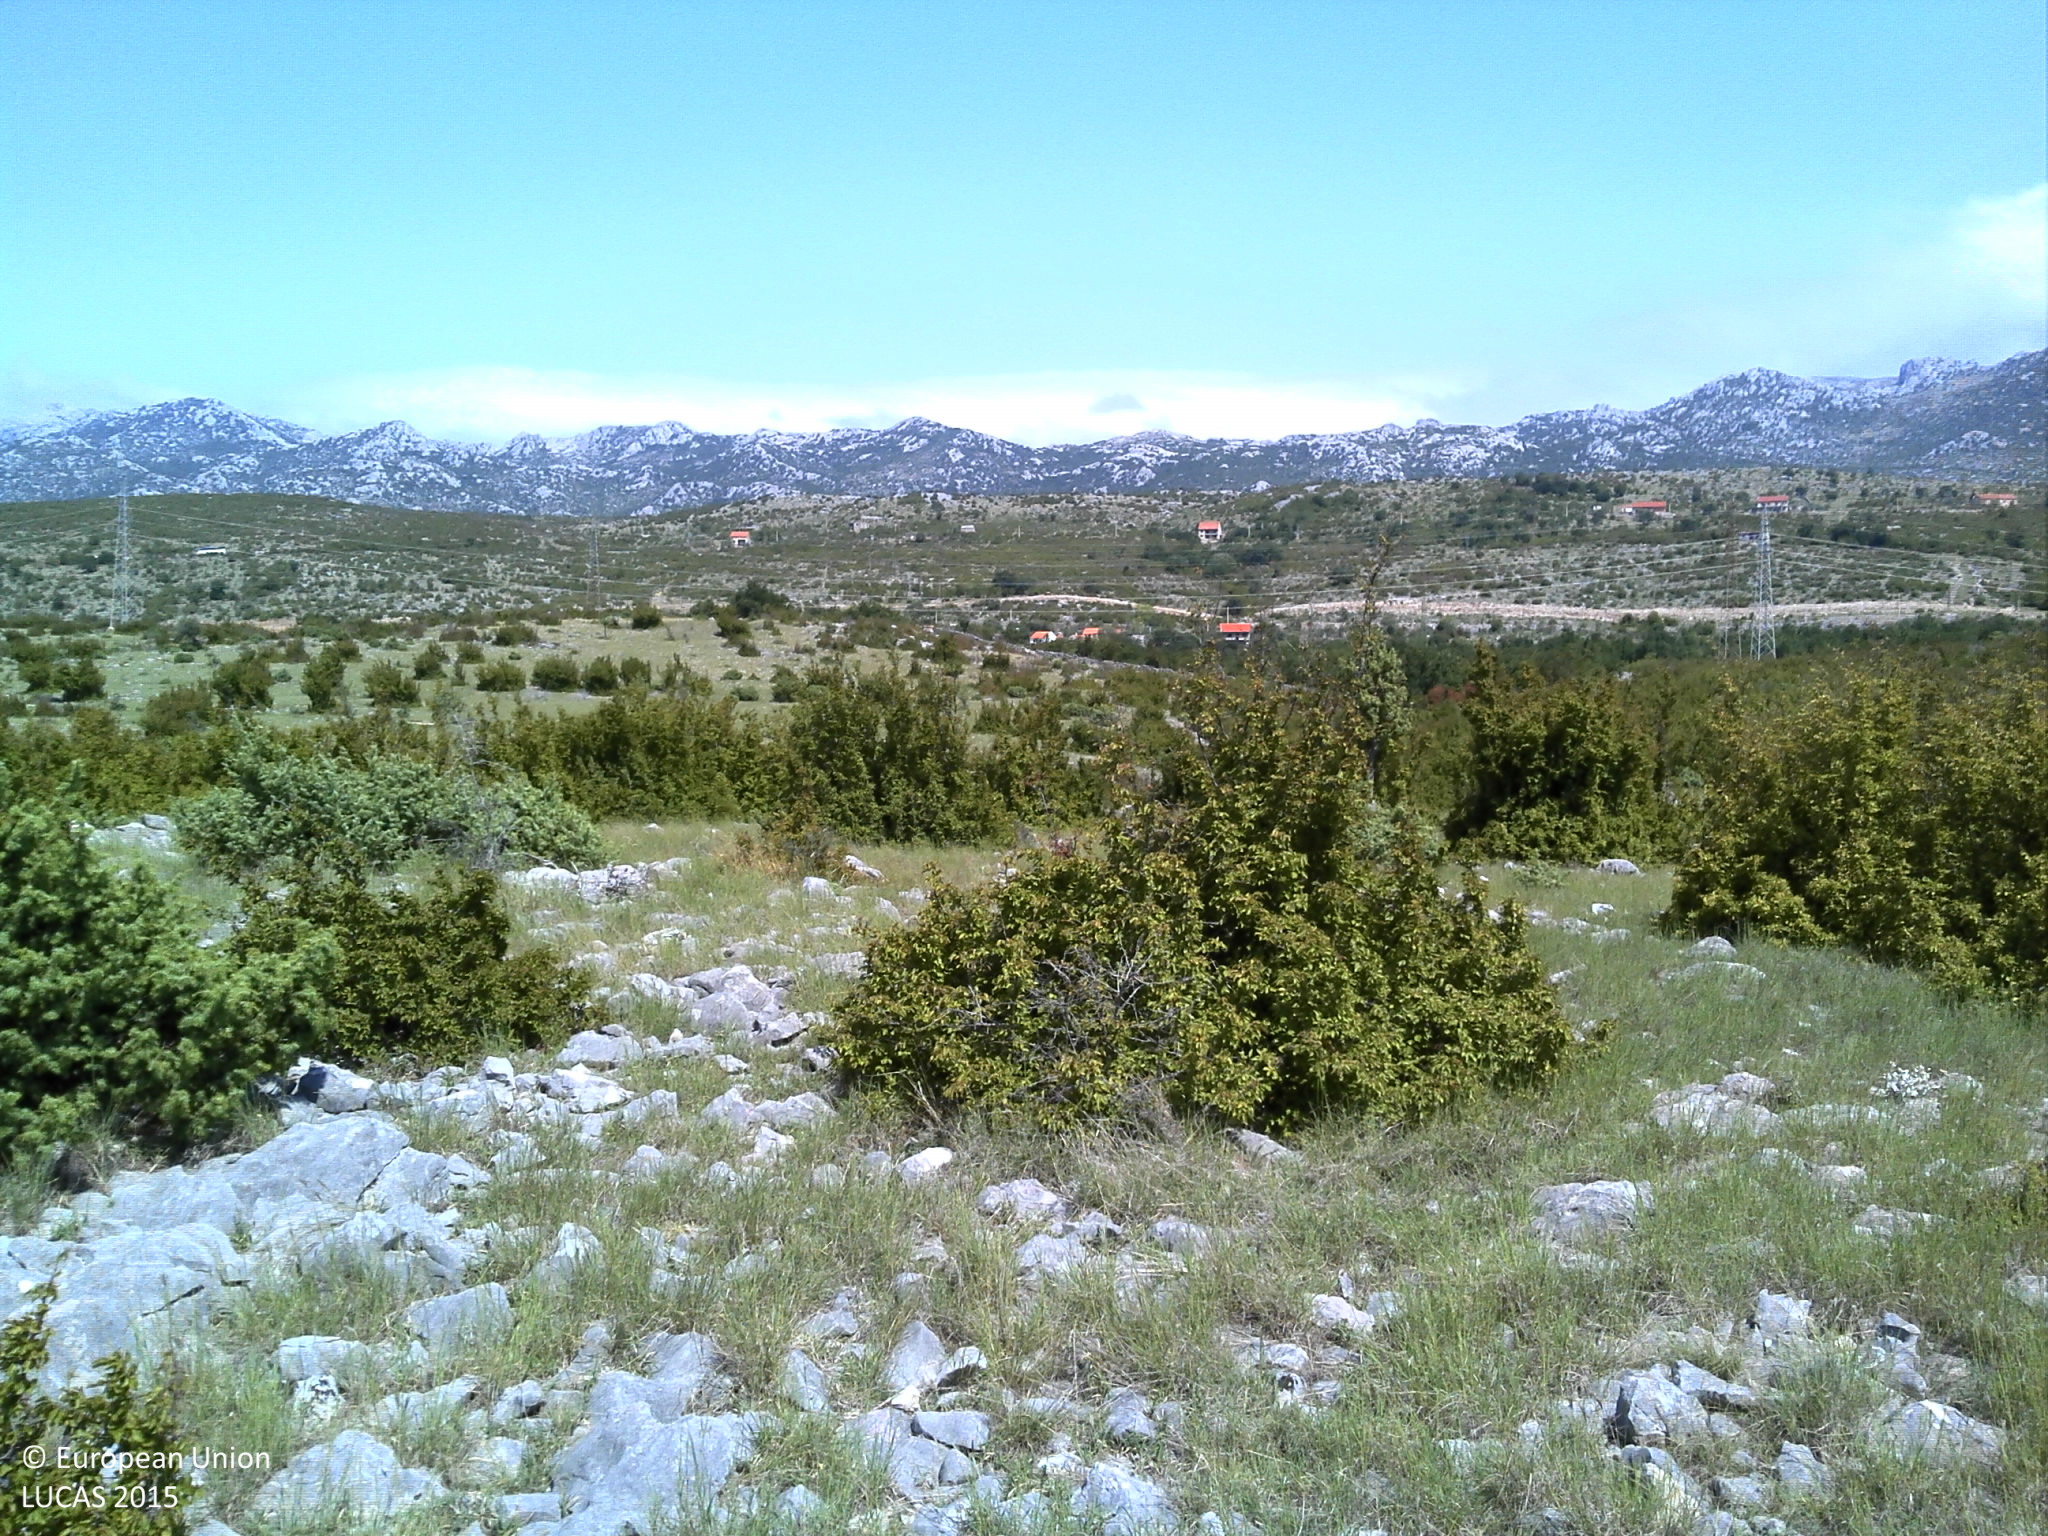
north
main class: Shrubland
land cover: Shrubland with sparse tree cover
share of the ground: > 75 %
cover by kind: shrubs 50 %, unconsolidated bare surface 25 %, herbaceous plants 20 %, broadleaved forest trees 5 %
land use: Semi-natural and natural areas not in use
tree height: < 5 m
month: August
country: HR
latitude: 44.2113
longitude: 15.7121
